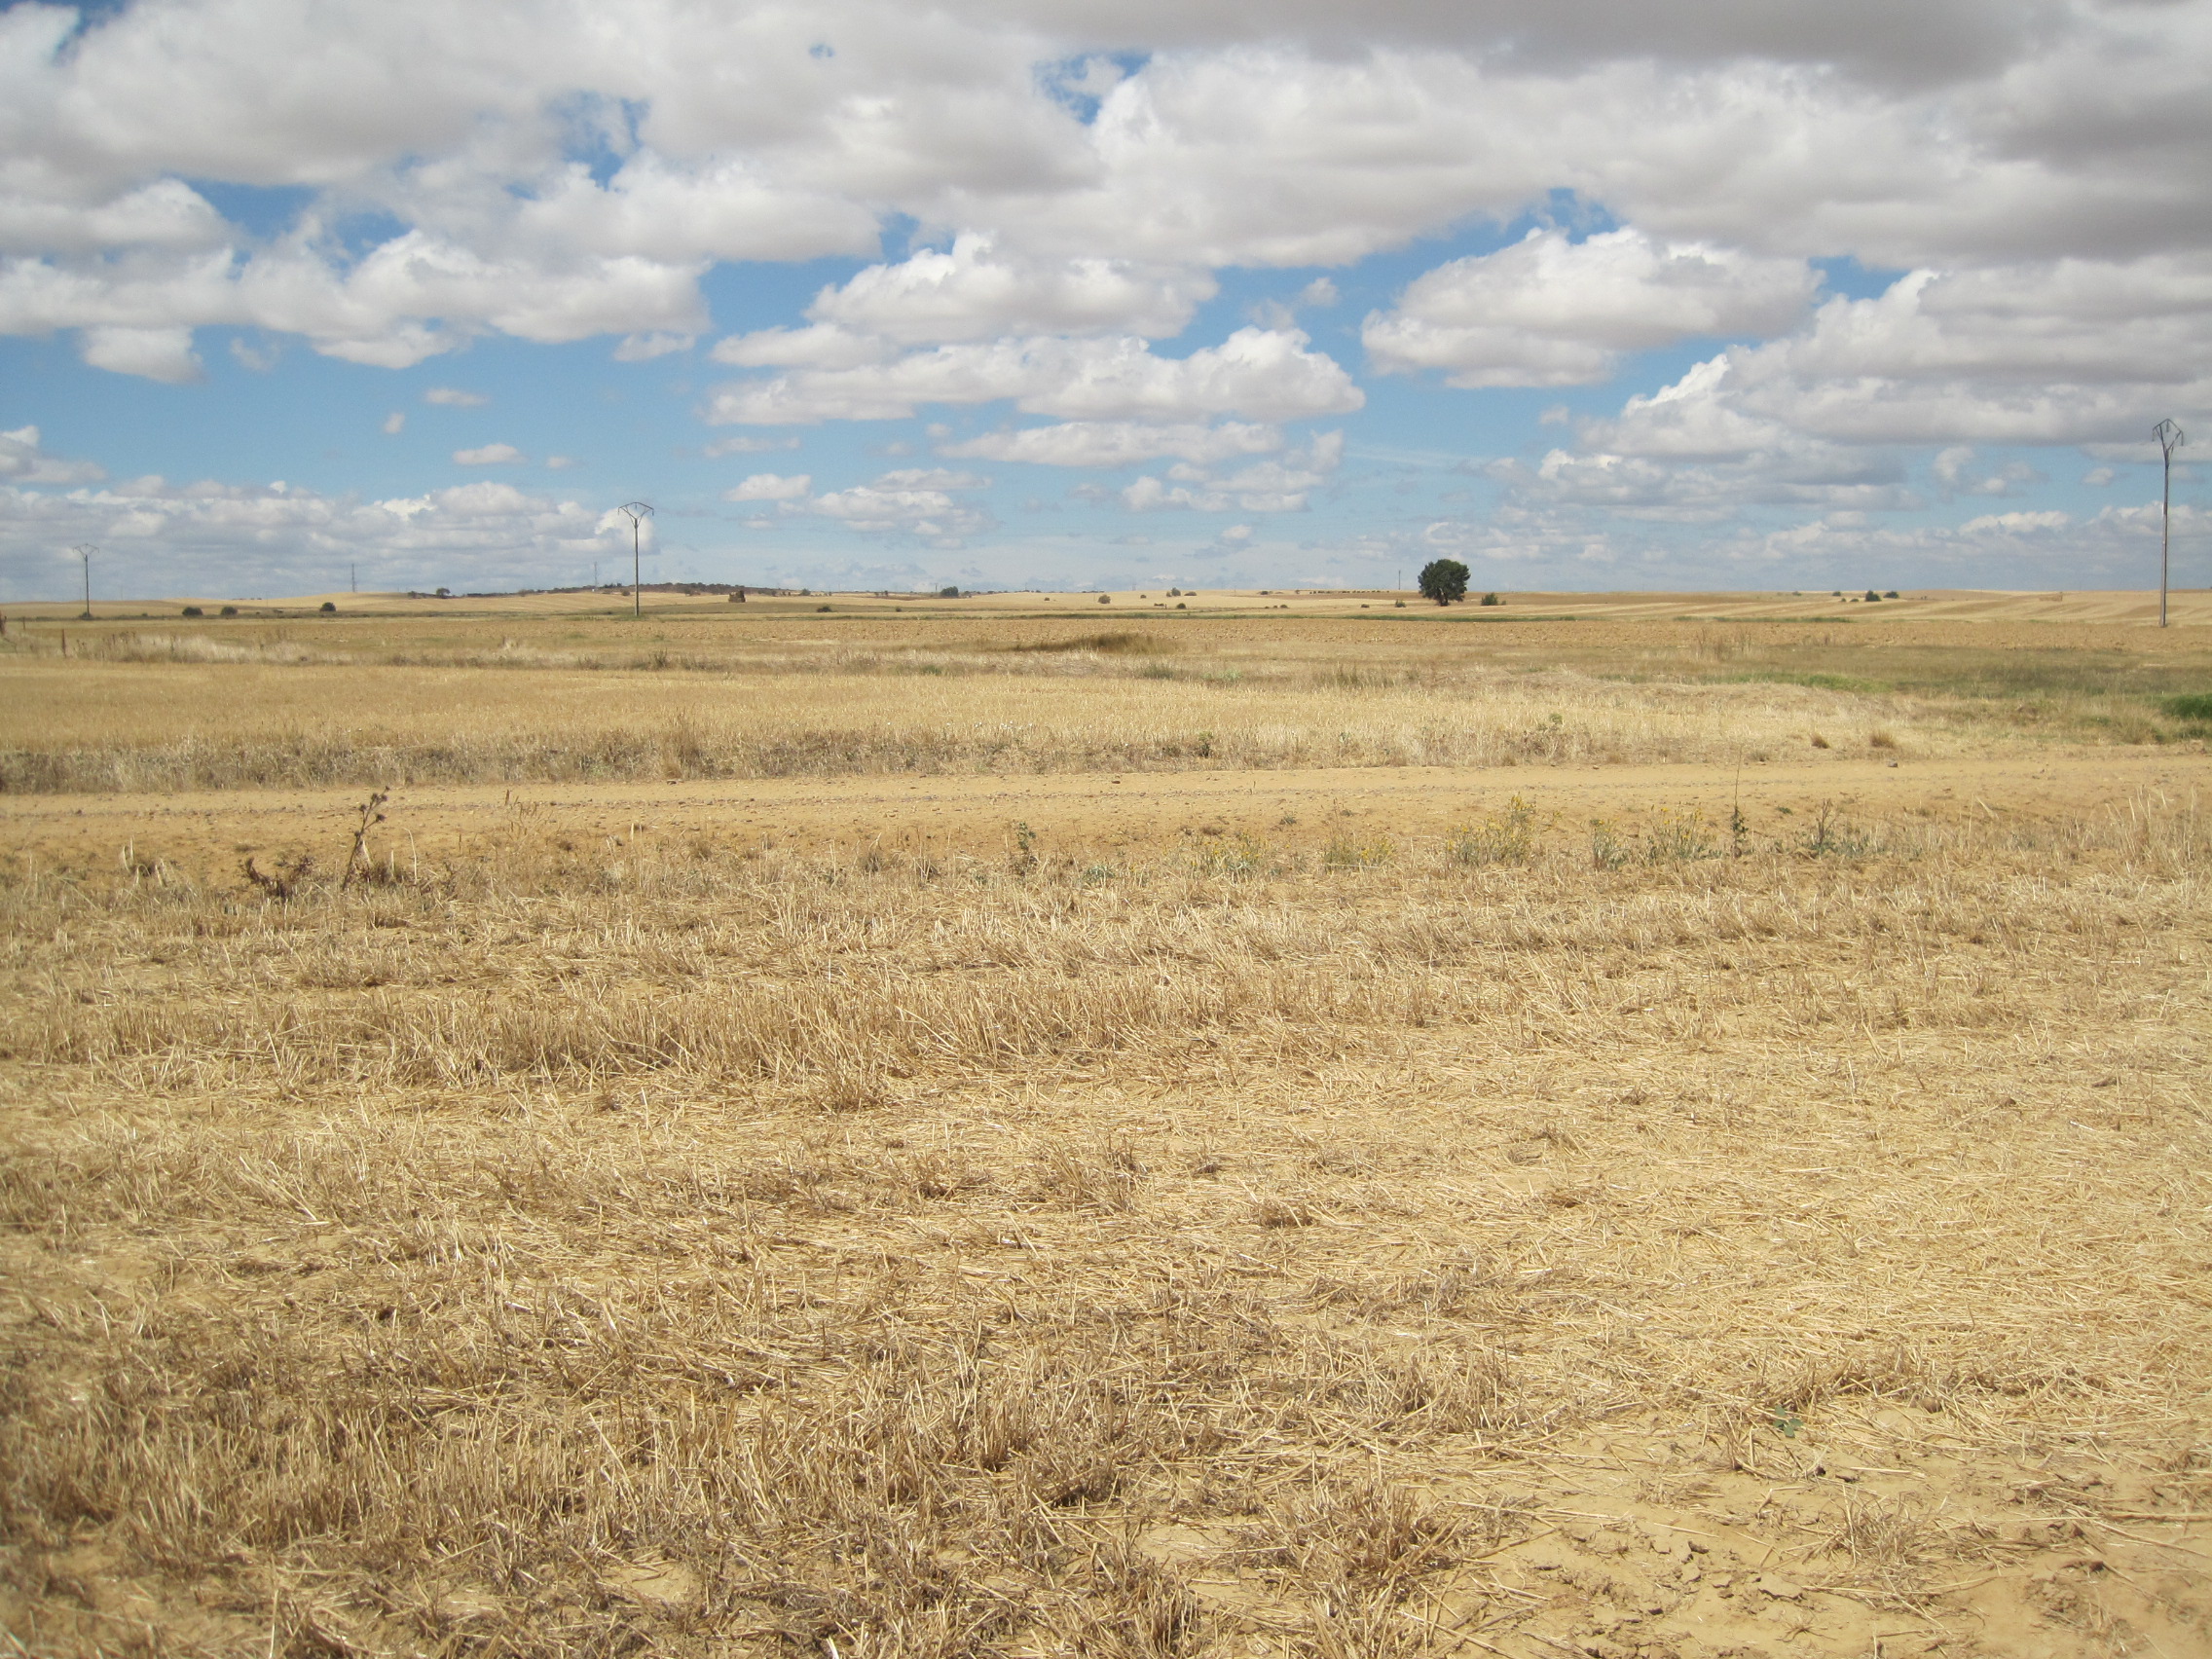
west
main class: Cropland
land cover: Barley
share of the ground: < 10 %
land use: Agriculture (excluding fallow land and kitchen gardens)
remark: Harvested field
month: July
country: ES
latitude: 41.8861
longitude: -5.4265
